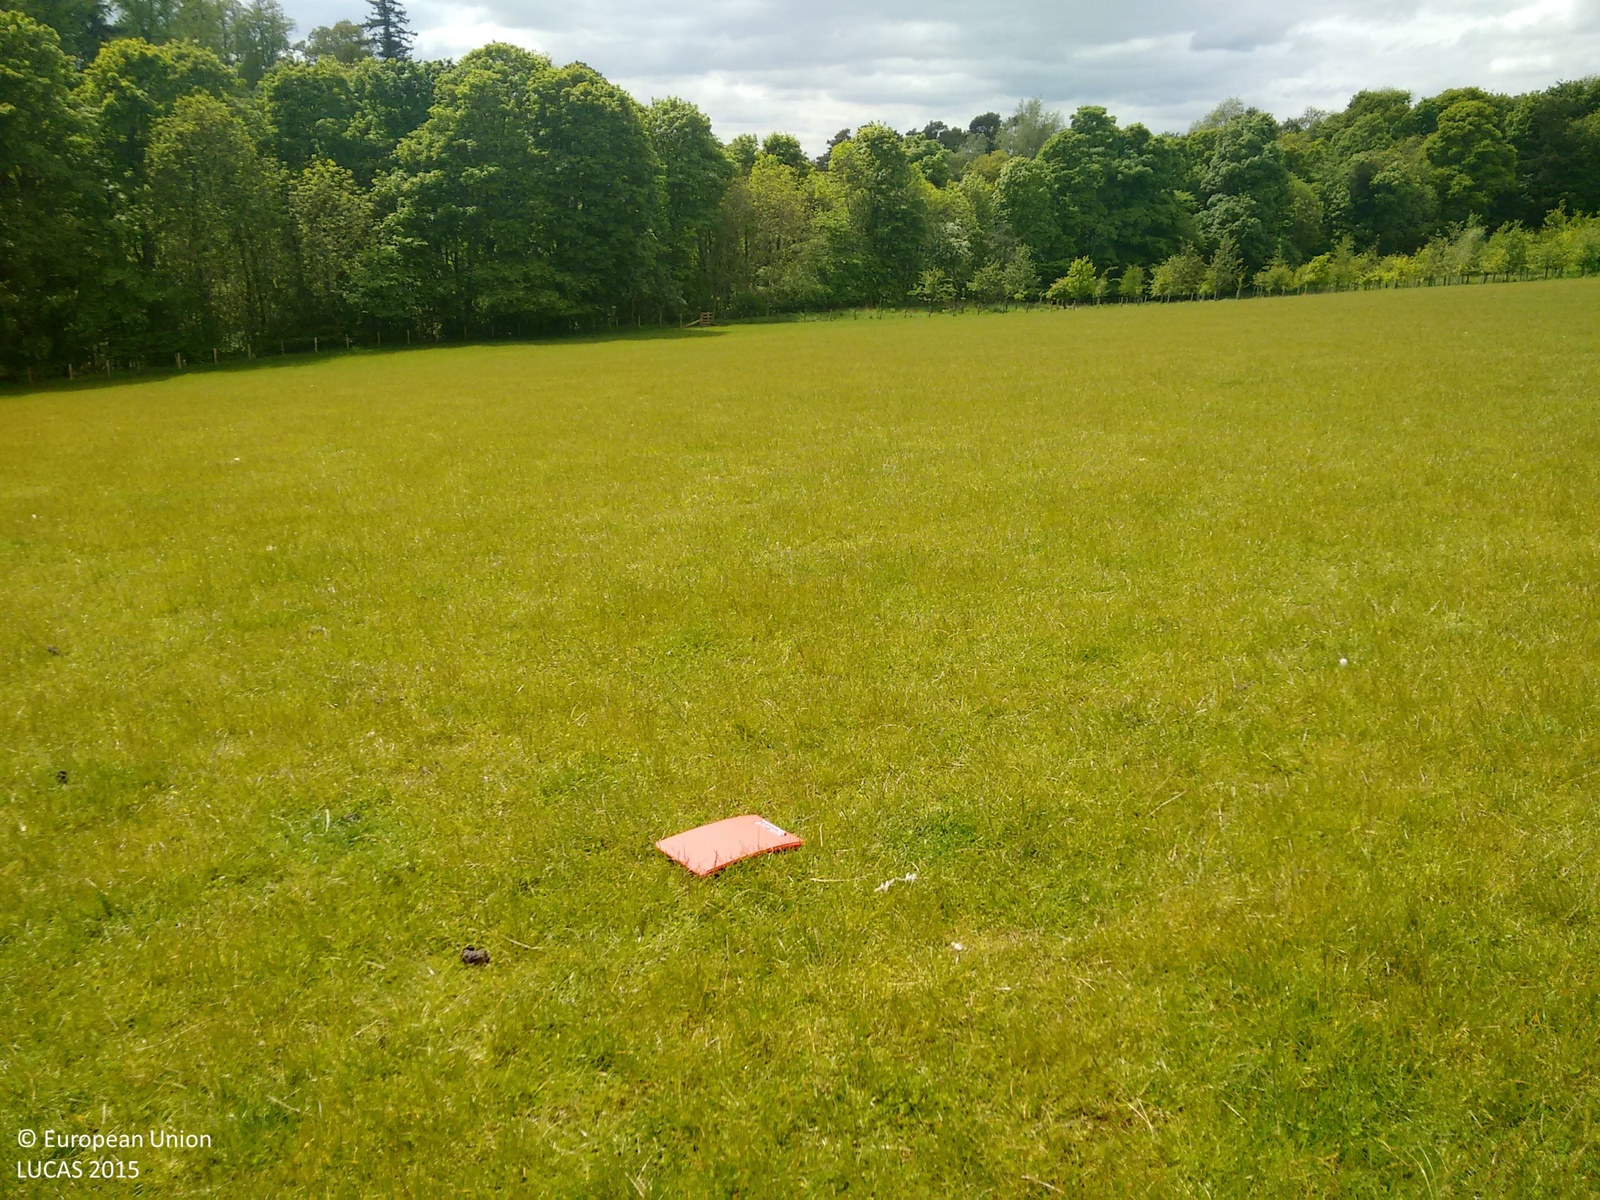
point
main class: Grassland
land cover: Grassland without tree/shrub cover
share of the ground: > 75 %
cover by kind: herbaceous plants 100 %
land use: Agriculture (excluding fallow land and kitchen gardens)
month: June
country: GB
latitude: 55.6316
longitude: -2.4652
